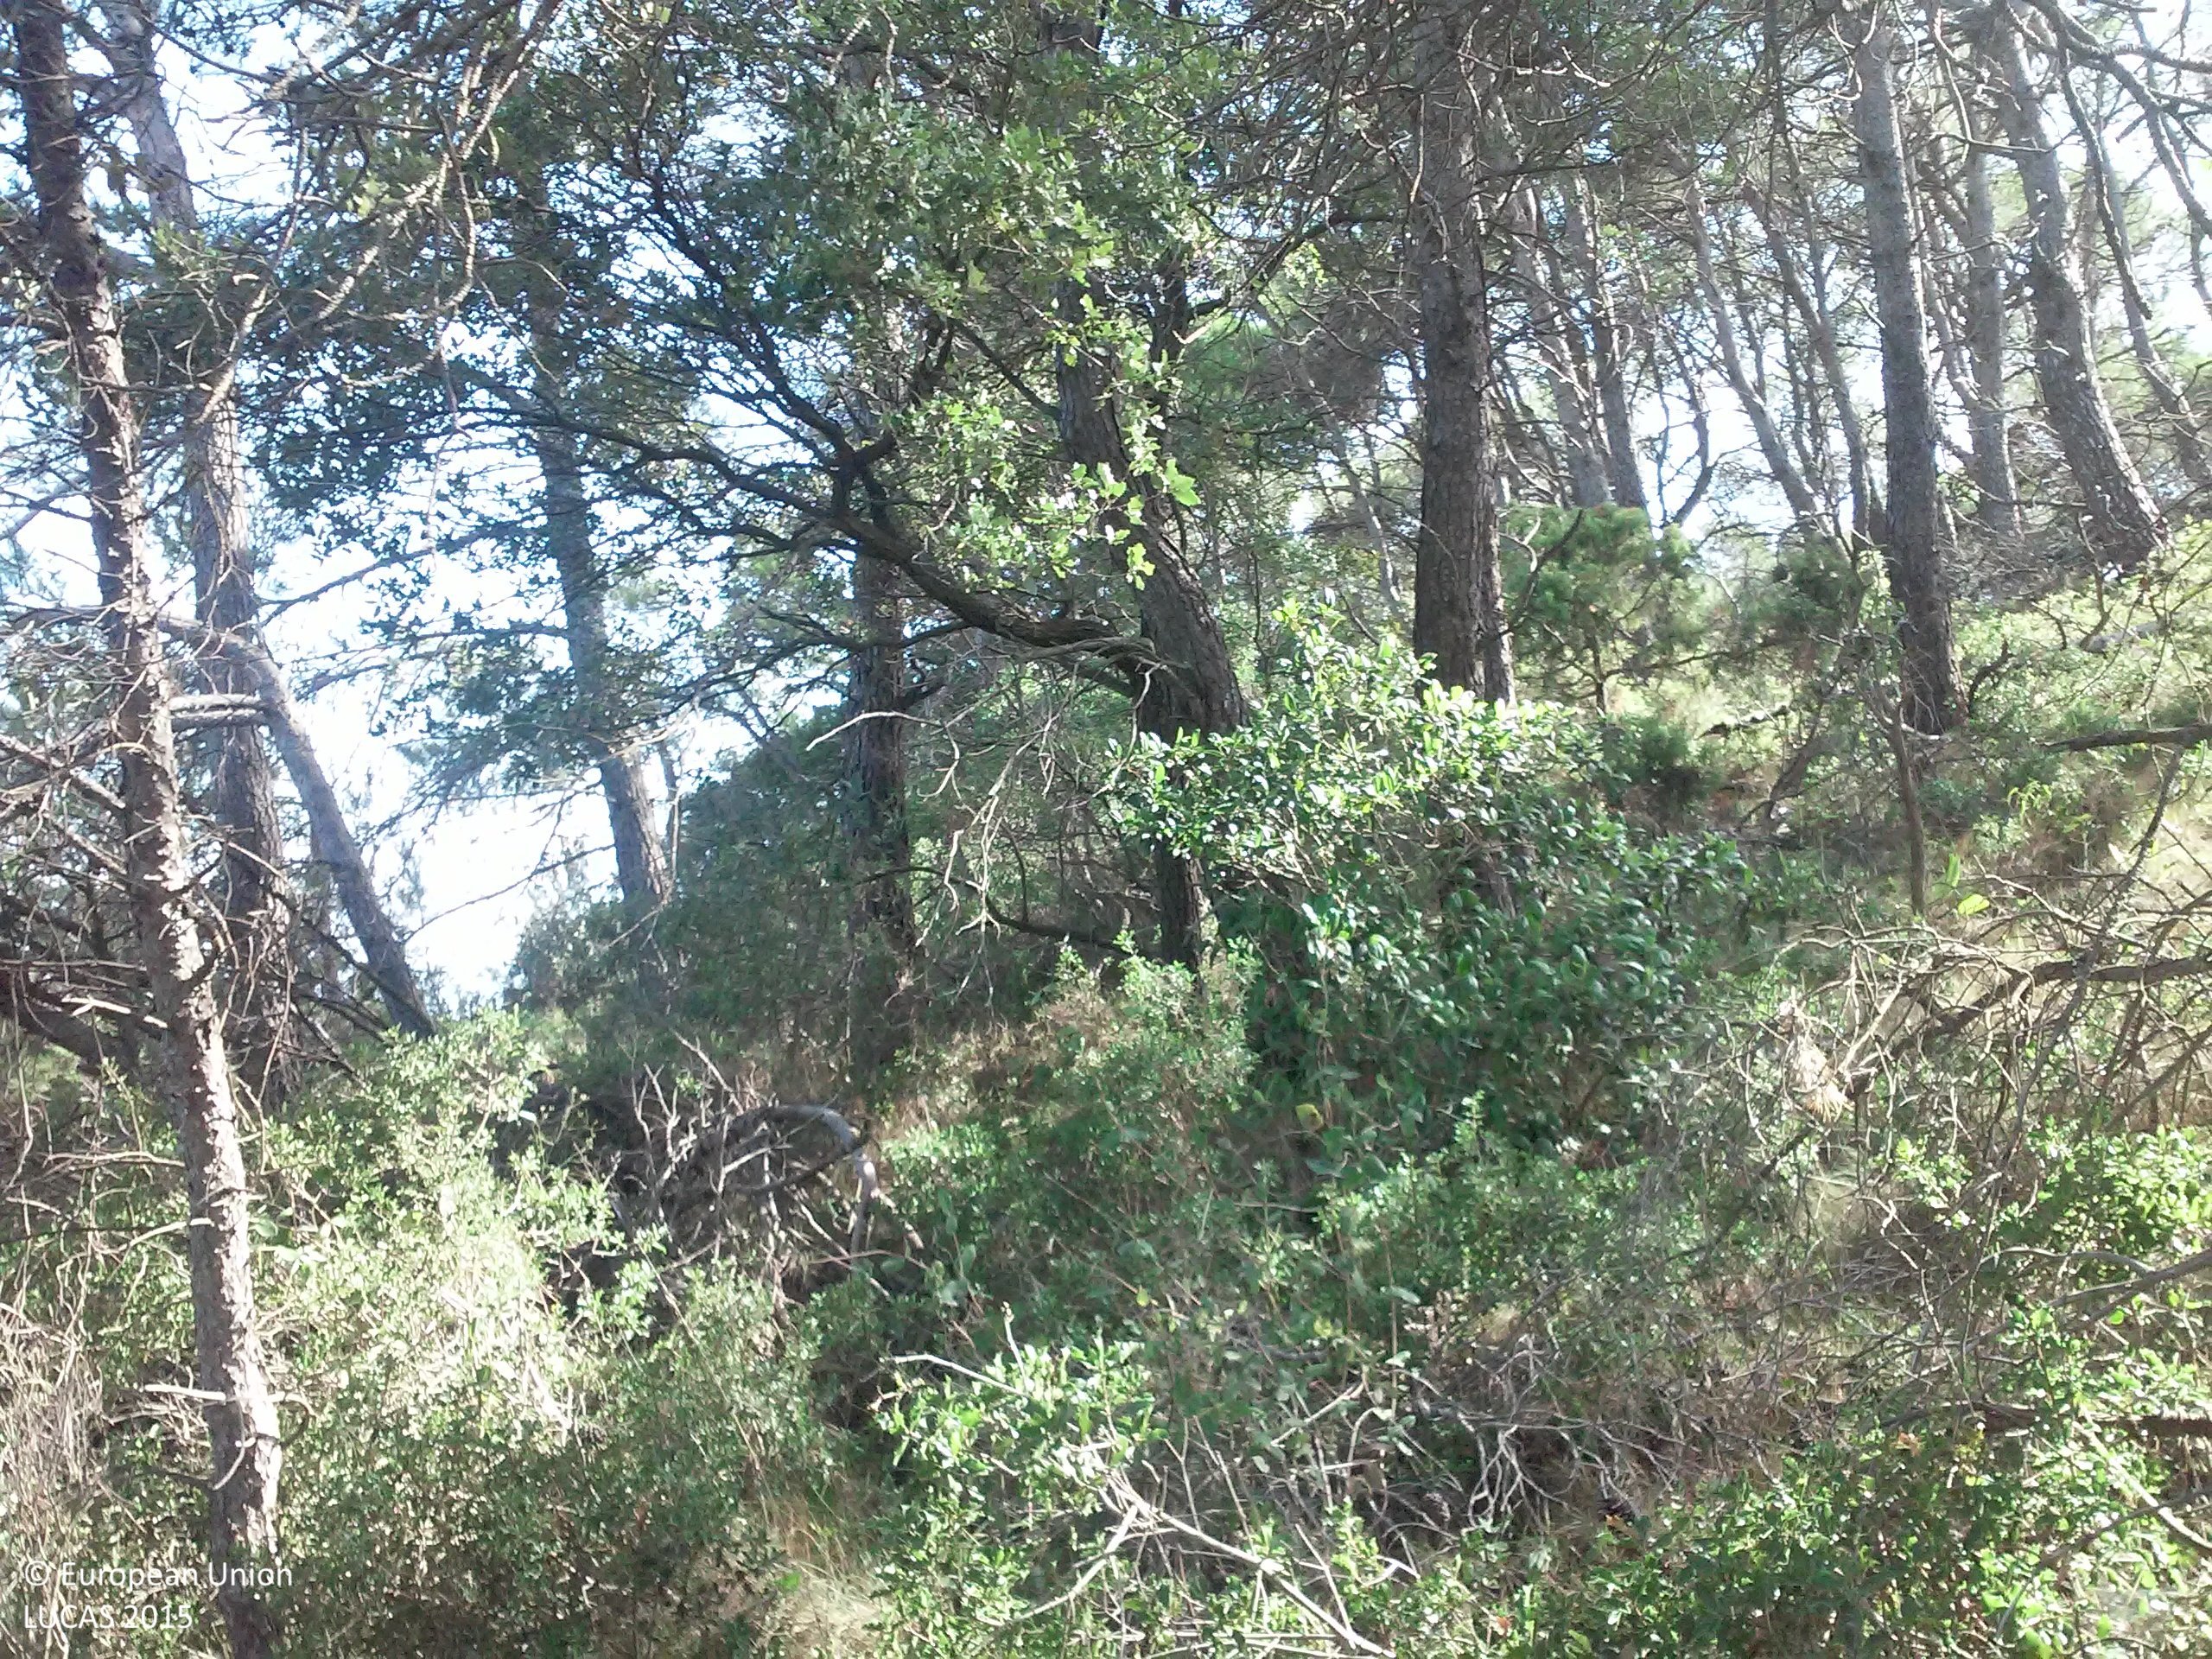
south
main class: Woodland
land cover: Pine dominated coniferous woodland
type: coniferous forest of the mediterranean region
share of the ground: 25 - 50 %
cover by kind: coniferous forest trees 30 %, shrubs 30 %, herbaceous plants 20 %, broadleaved forest trees 10 %, consolidated bare surface 10 %
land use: Semi-natural and natural areas not in use
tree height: < 5 m
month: August
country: ES
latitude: 41.1515
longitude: 0.4940
